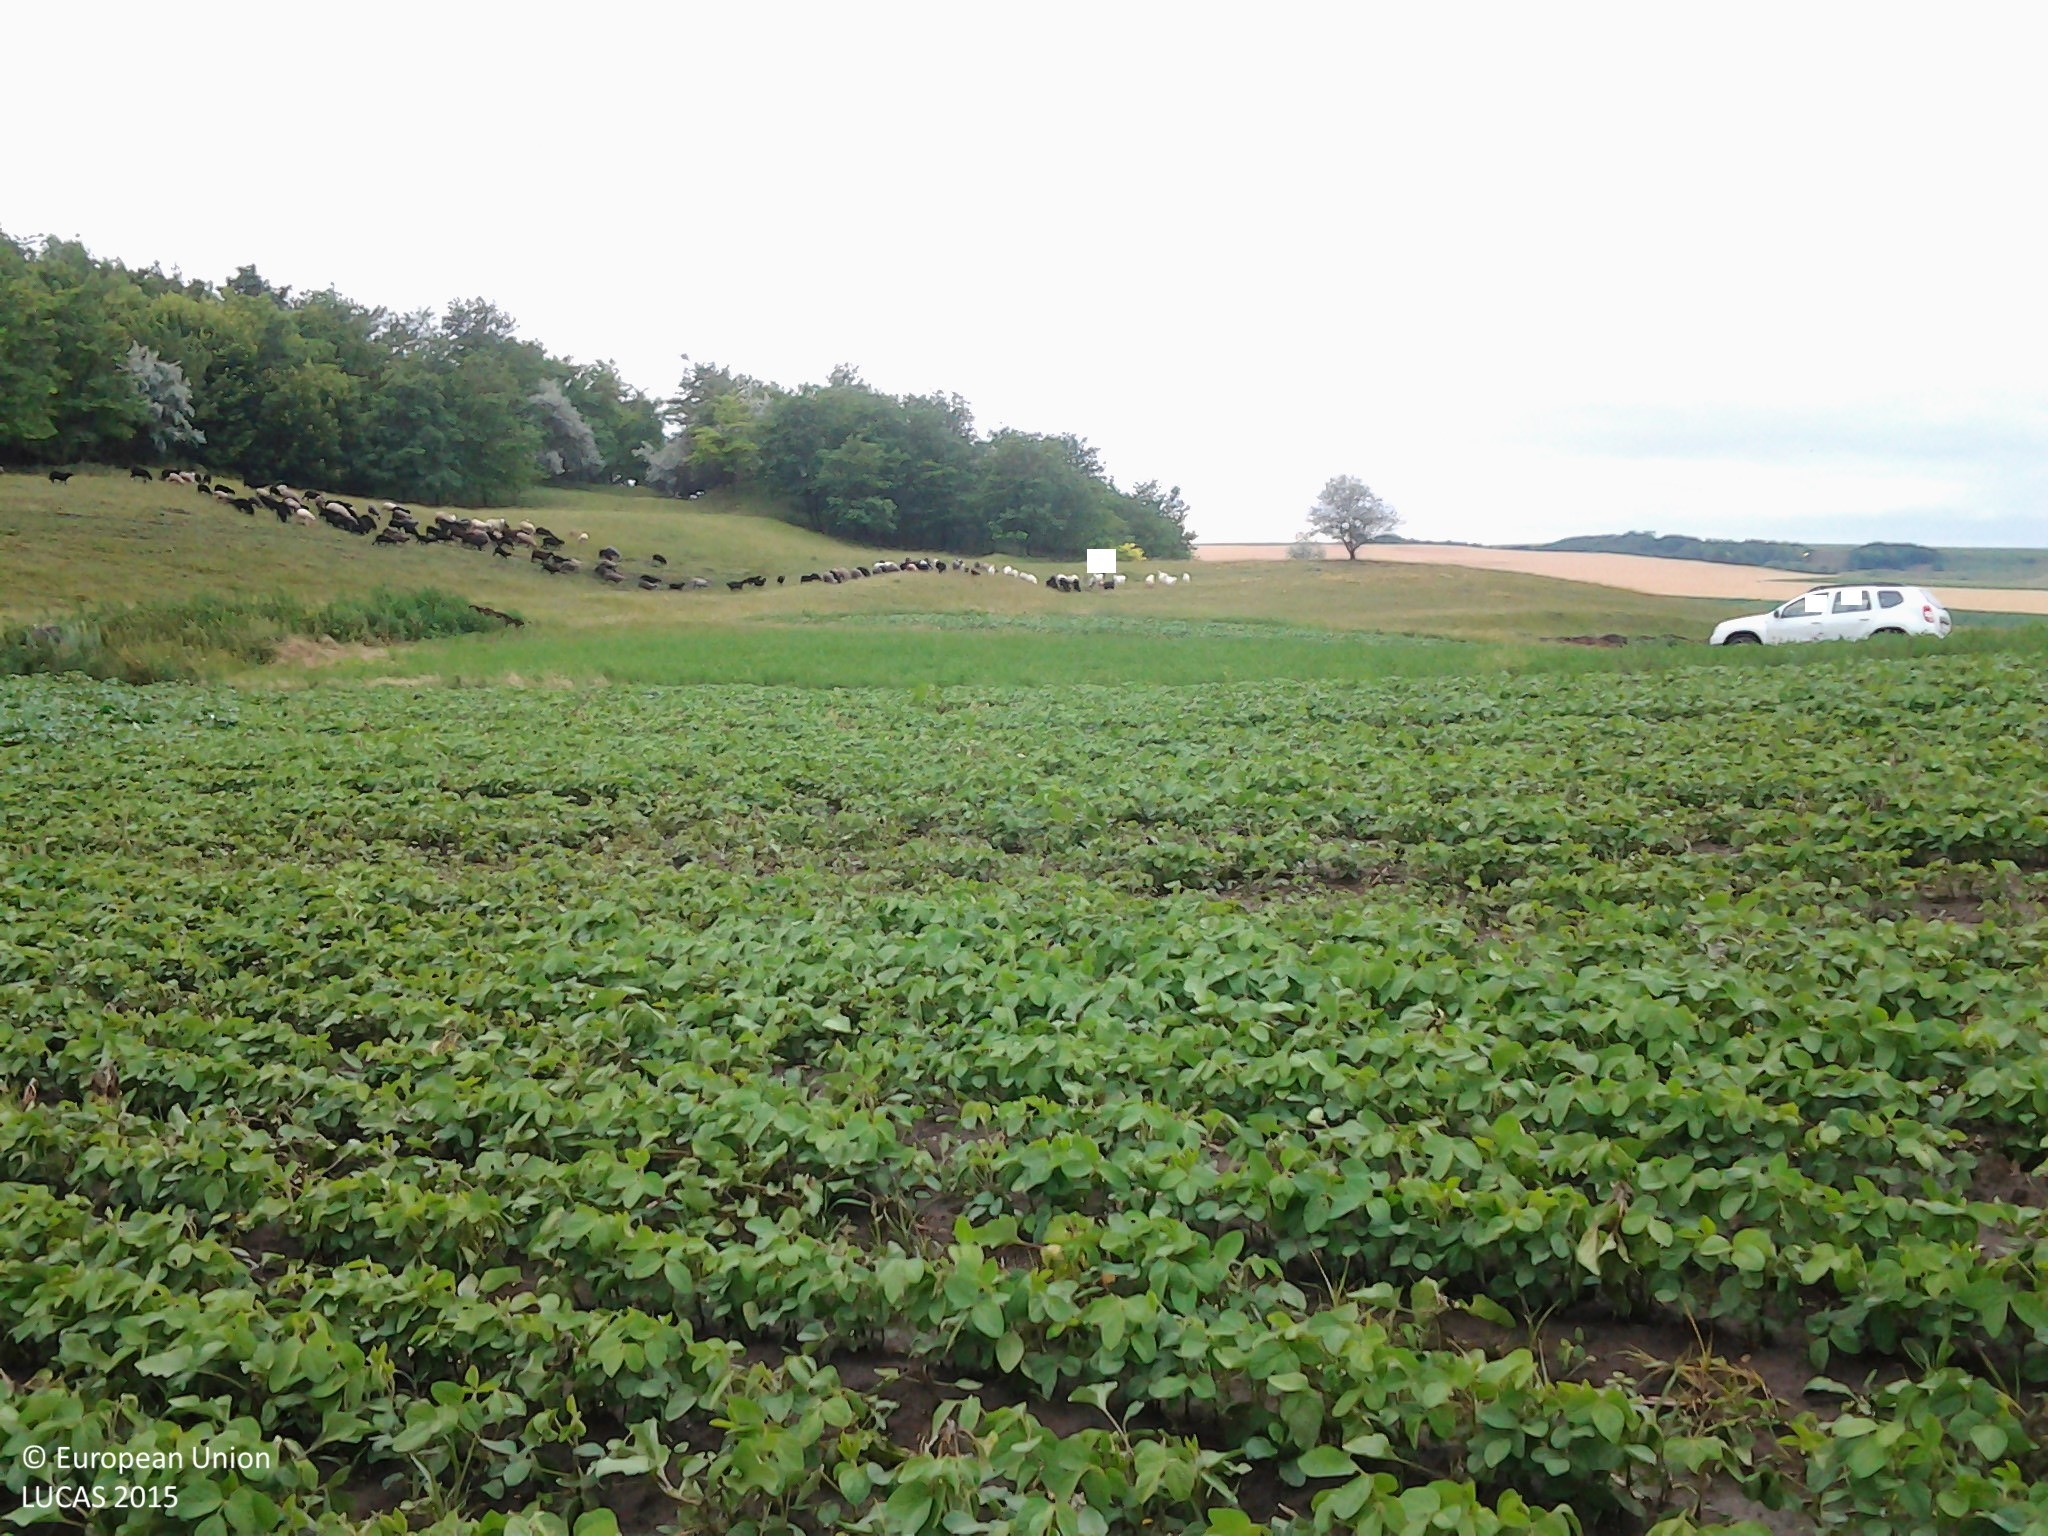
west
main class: Cropland
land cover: Soya
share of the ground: 50 - 75 %
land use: Agriculture (excluding fallow land and kitchen gardens)
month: June
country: RO
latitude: 47.9218
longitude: 26.5122
